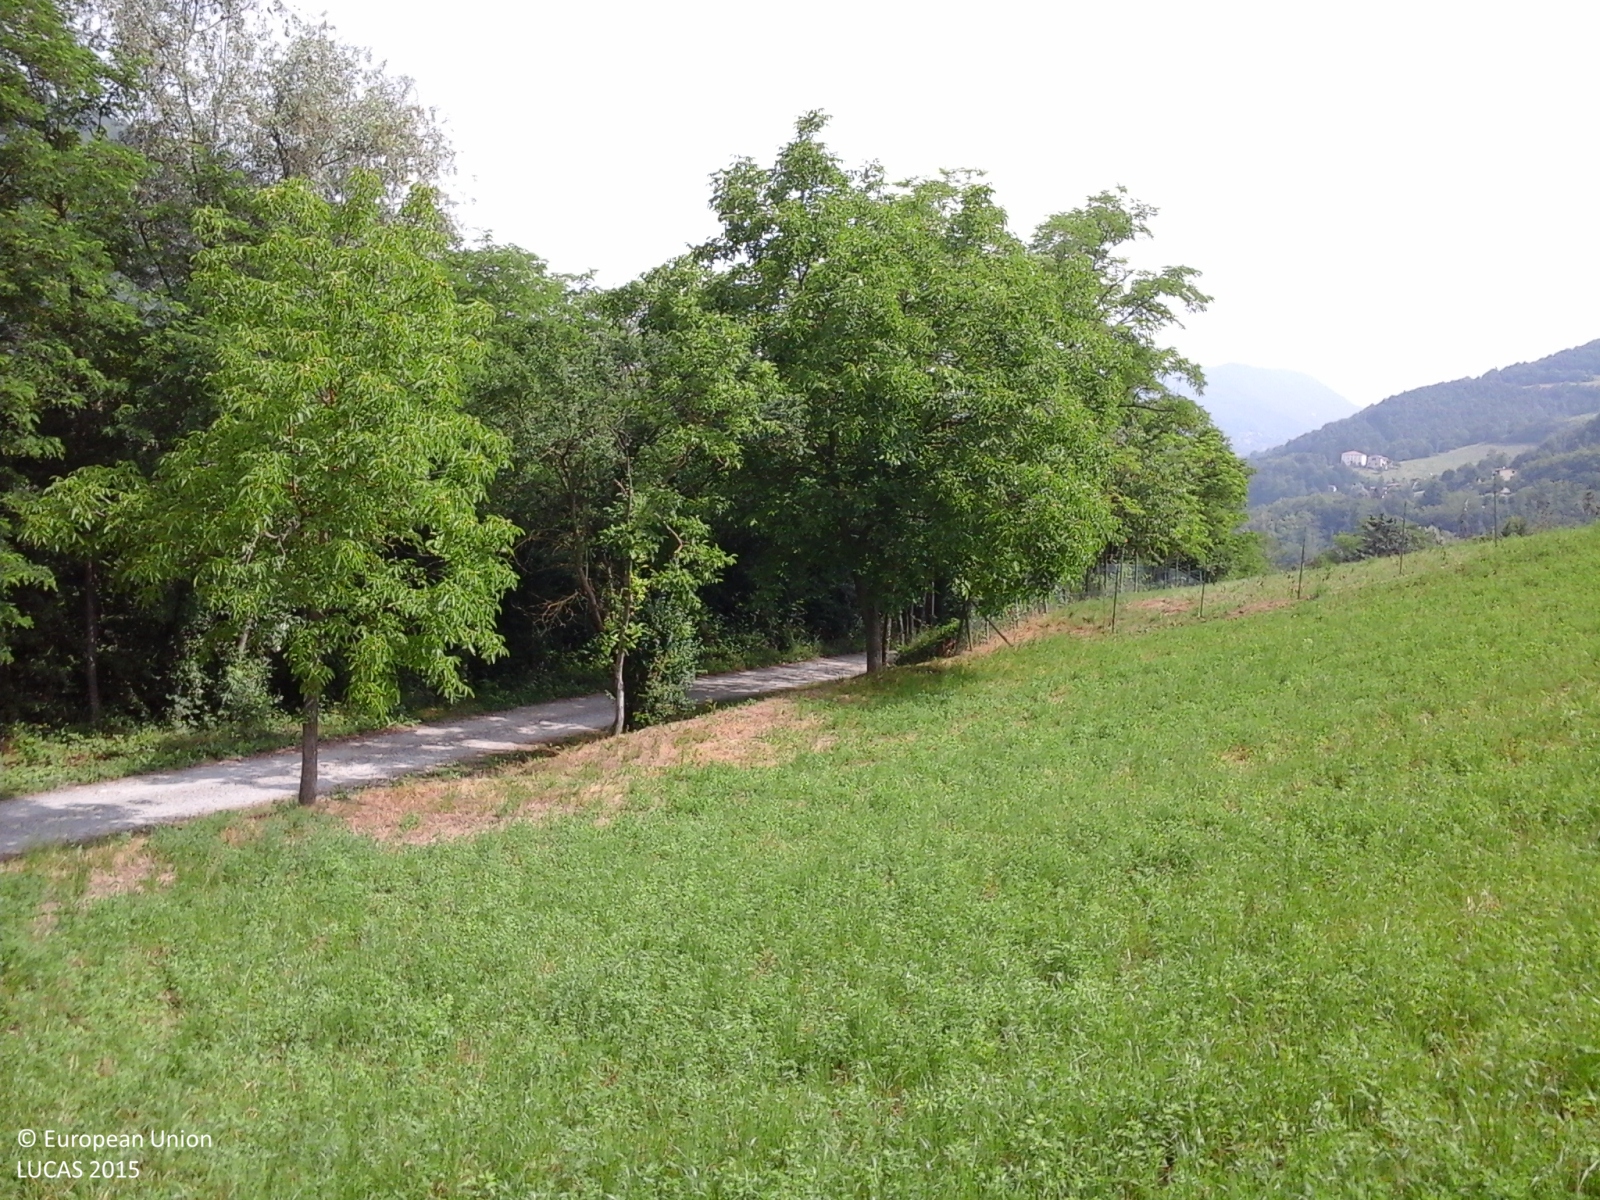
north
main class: Cropland
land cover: Lucerne
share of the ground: > 75 %
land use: Agriculture (excluding fallow land and kitchen gardens)
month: June
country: IT
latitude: 44.8006
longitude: 9.6089
